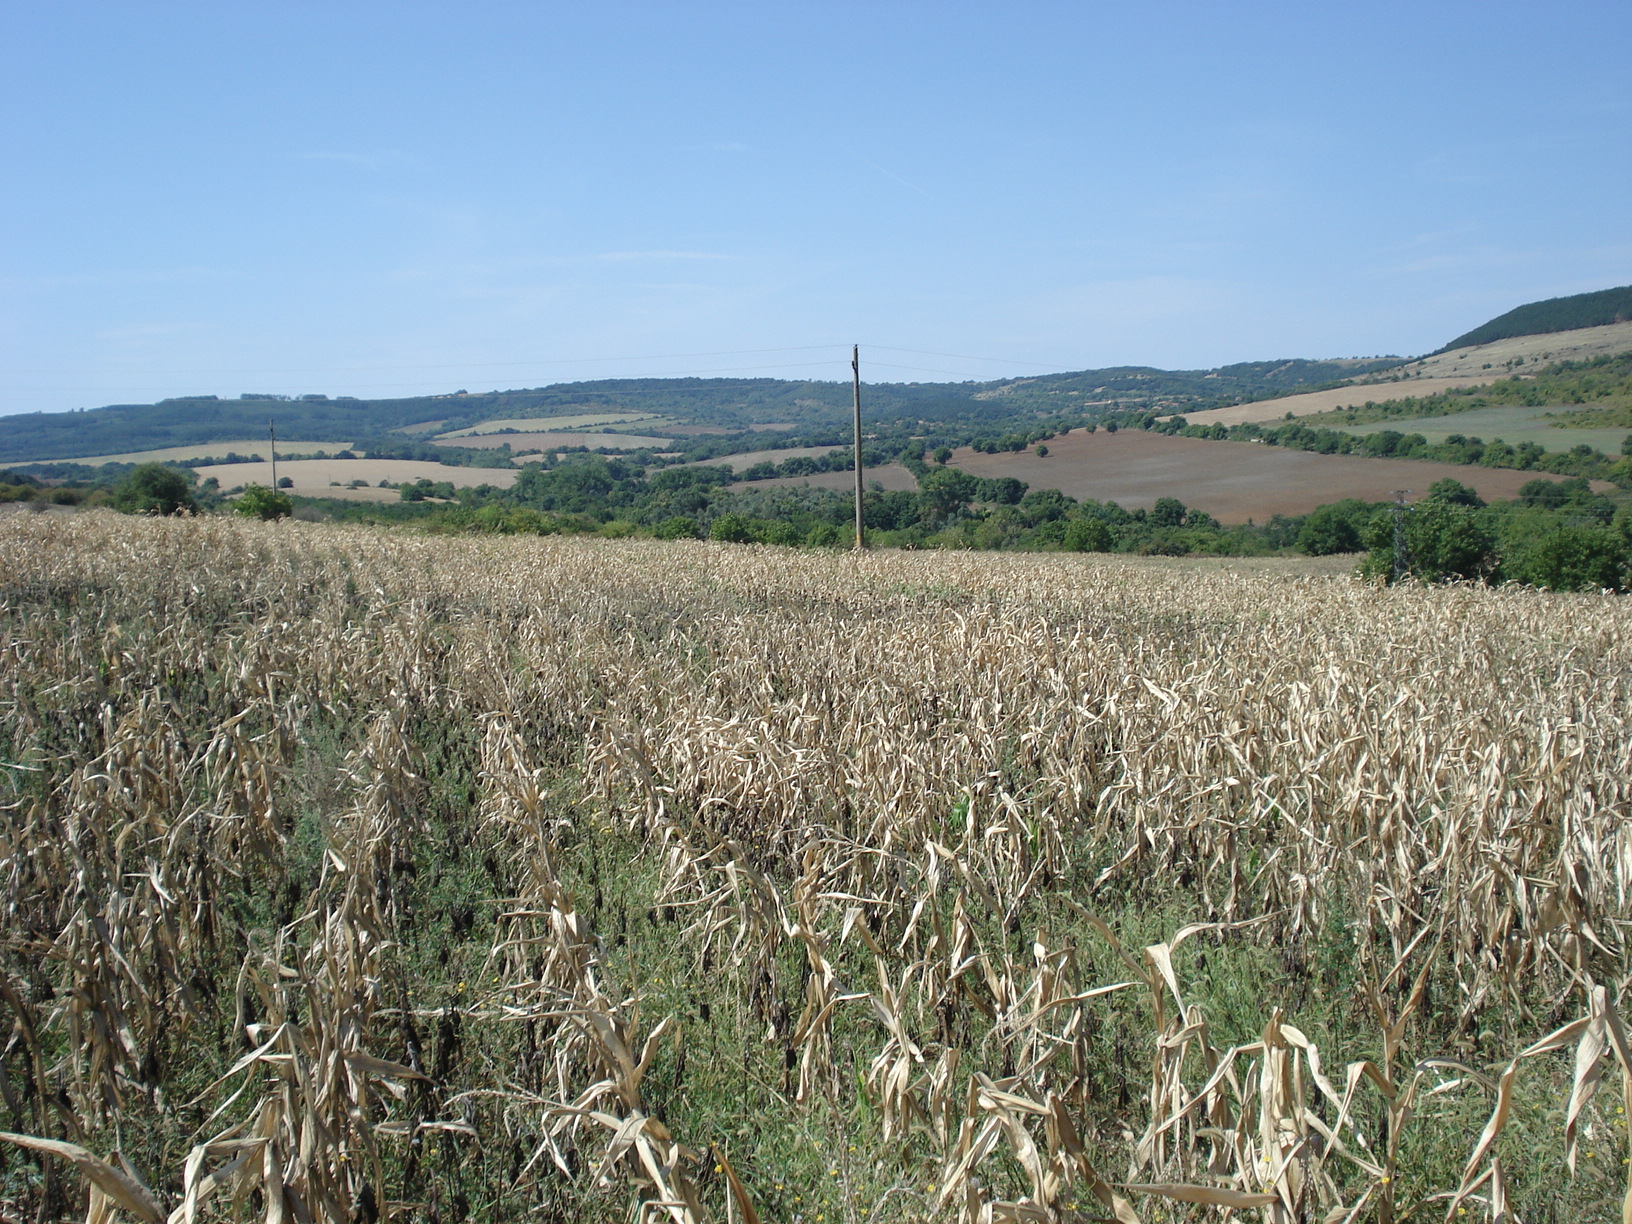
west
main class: Cropland
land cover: Maize
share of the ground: > 75 %
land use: Agriculture (excluding fallow land and kitchen gardens)
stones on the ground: < 10 %
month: September
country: BG
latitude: 43.1478
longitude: 25.3338
